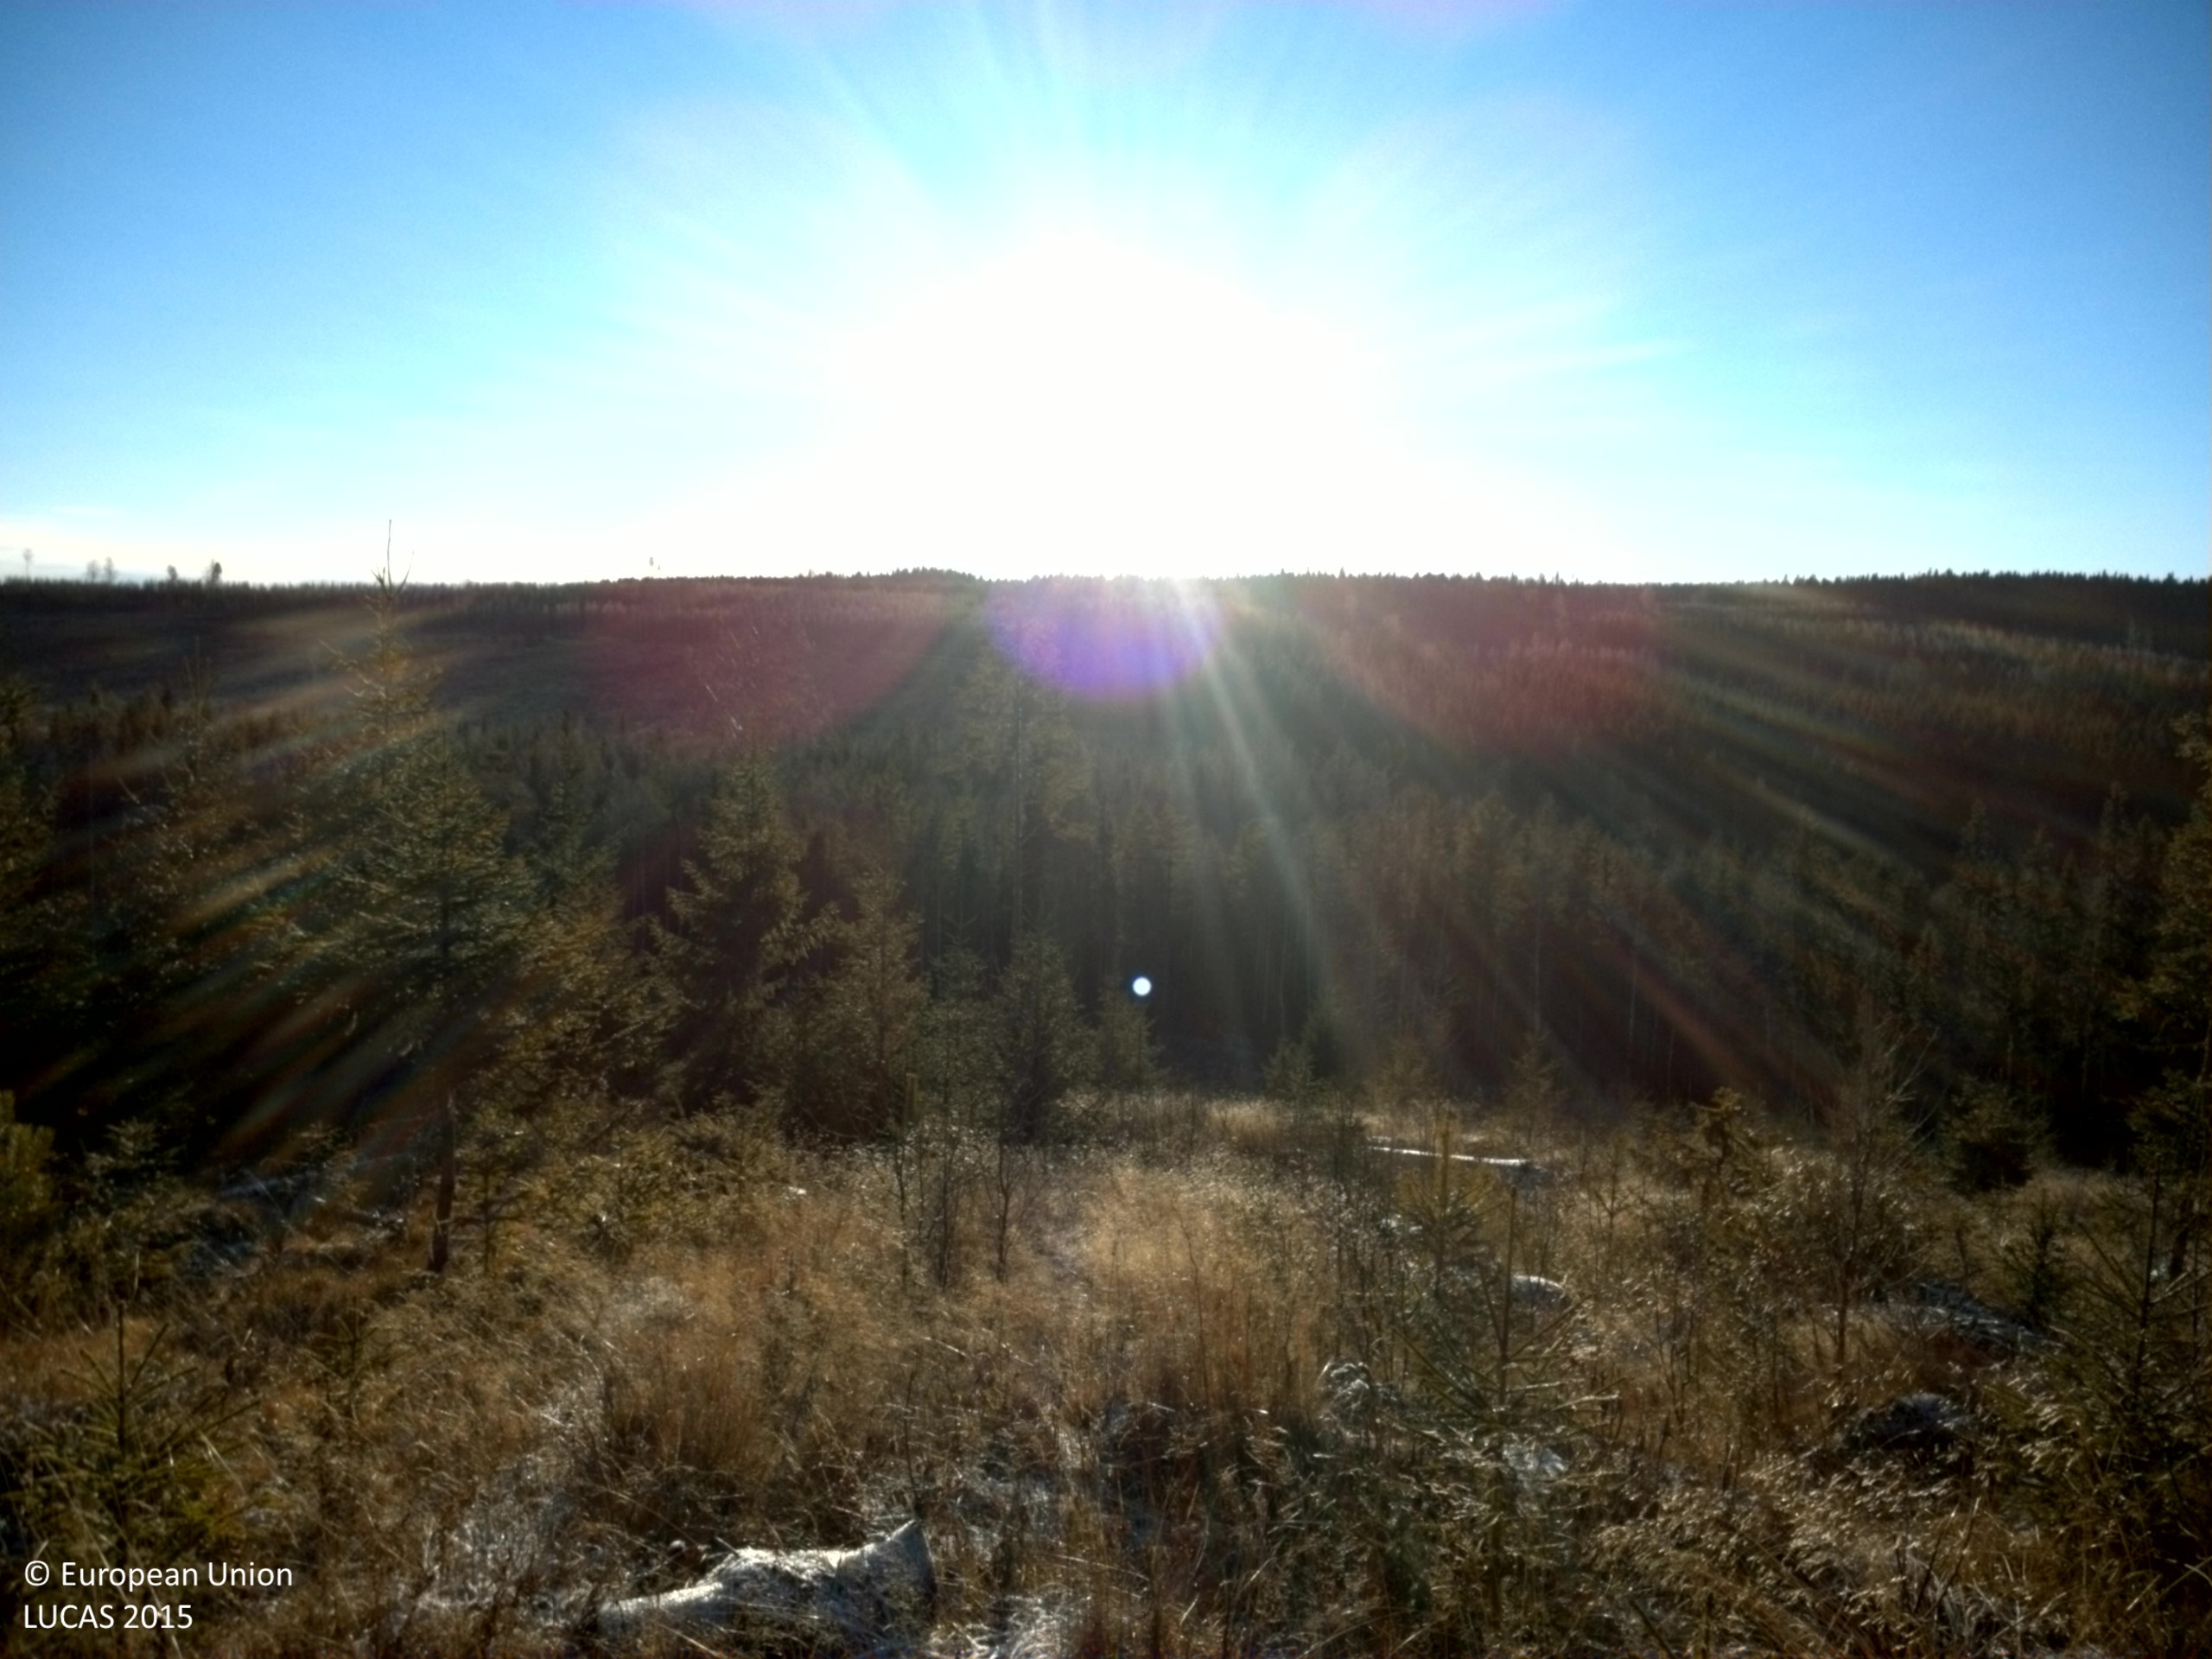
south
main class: Woodland
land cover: Spruce dominated mixed woodland
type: boreal forest
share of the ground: 25 - 50 %
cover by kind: herbaceous plants 50 %, coniferous forest trees 25 %, broadleaved forest trees 10 %, lichens and mosses 10 %, shrubs 5 %
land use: Forestry
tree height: < 5 m
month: November
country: SE
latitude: 61.8877
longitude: 16.2029
